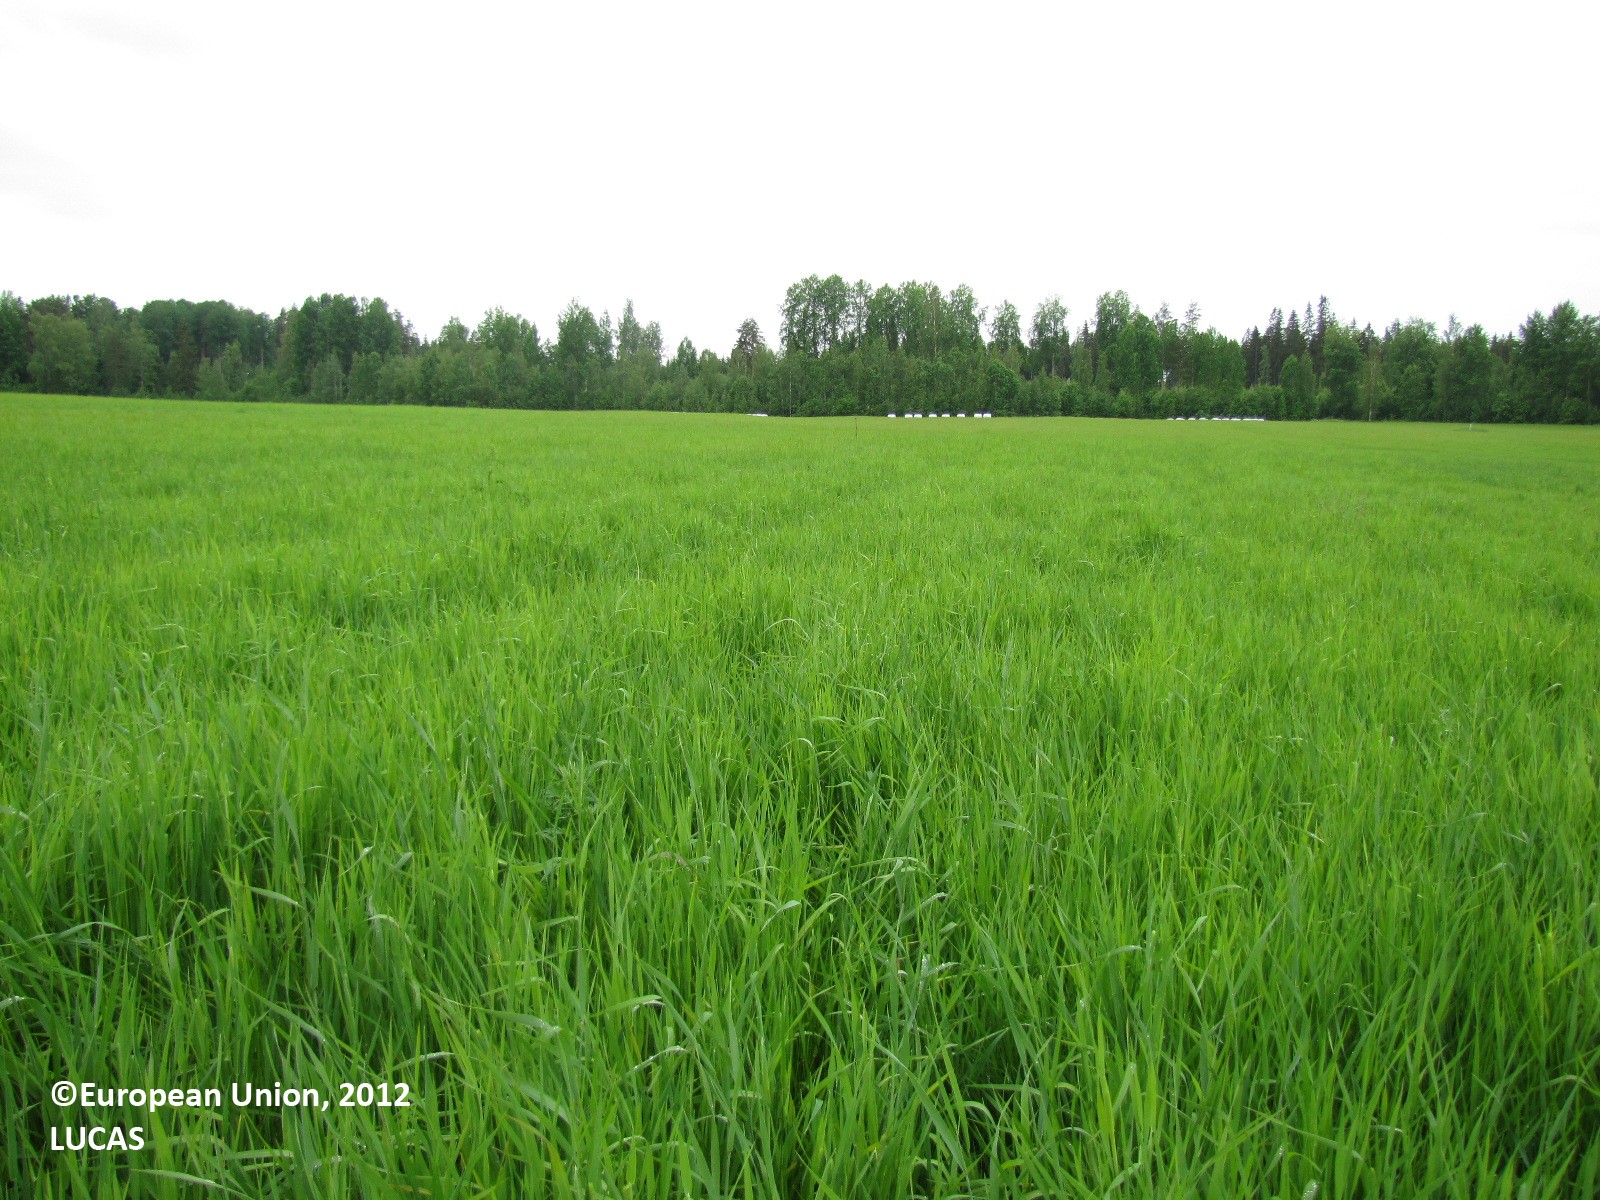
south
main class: Cropland
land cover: Temporary grasslands
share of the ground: > 75 %
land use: Agriculture (excluding fallow land and kitchen gardens)
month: June
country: FI
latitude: 61.4814
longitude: 24.6913
